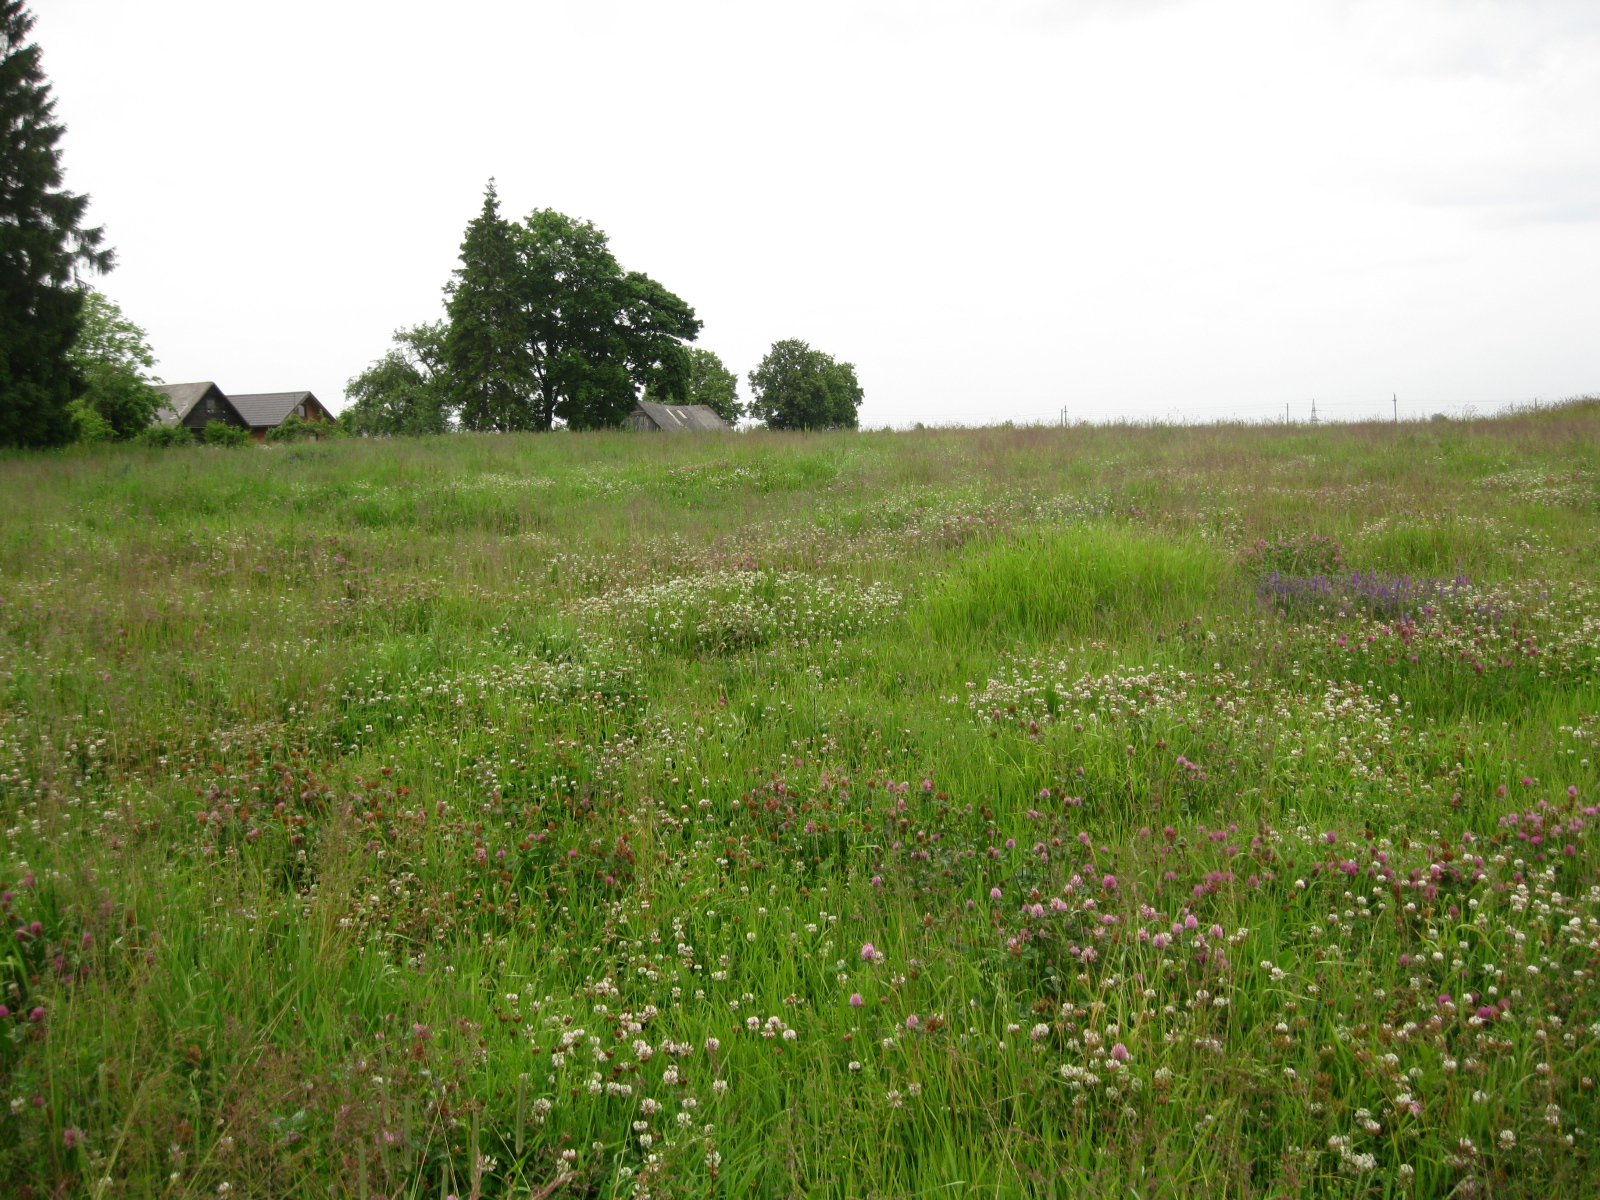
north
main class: Grassland
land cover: Grassland without tree/shrub cover
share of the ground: > 75 %
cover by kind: herbaceous plants 100 %
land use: Agriculture (excluding fallow land and kitchen gardens)
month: June
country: LT
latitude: 55.1894
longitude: 24.0550
